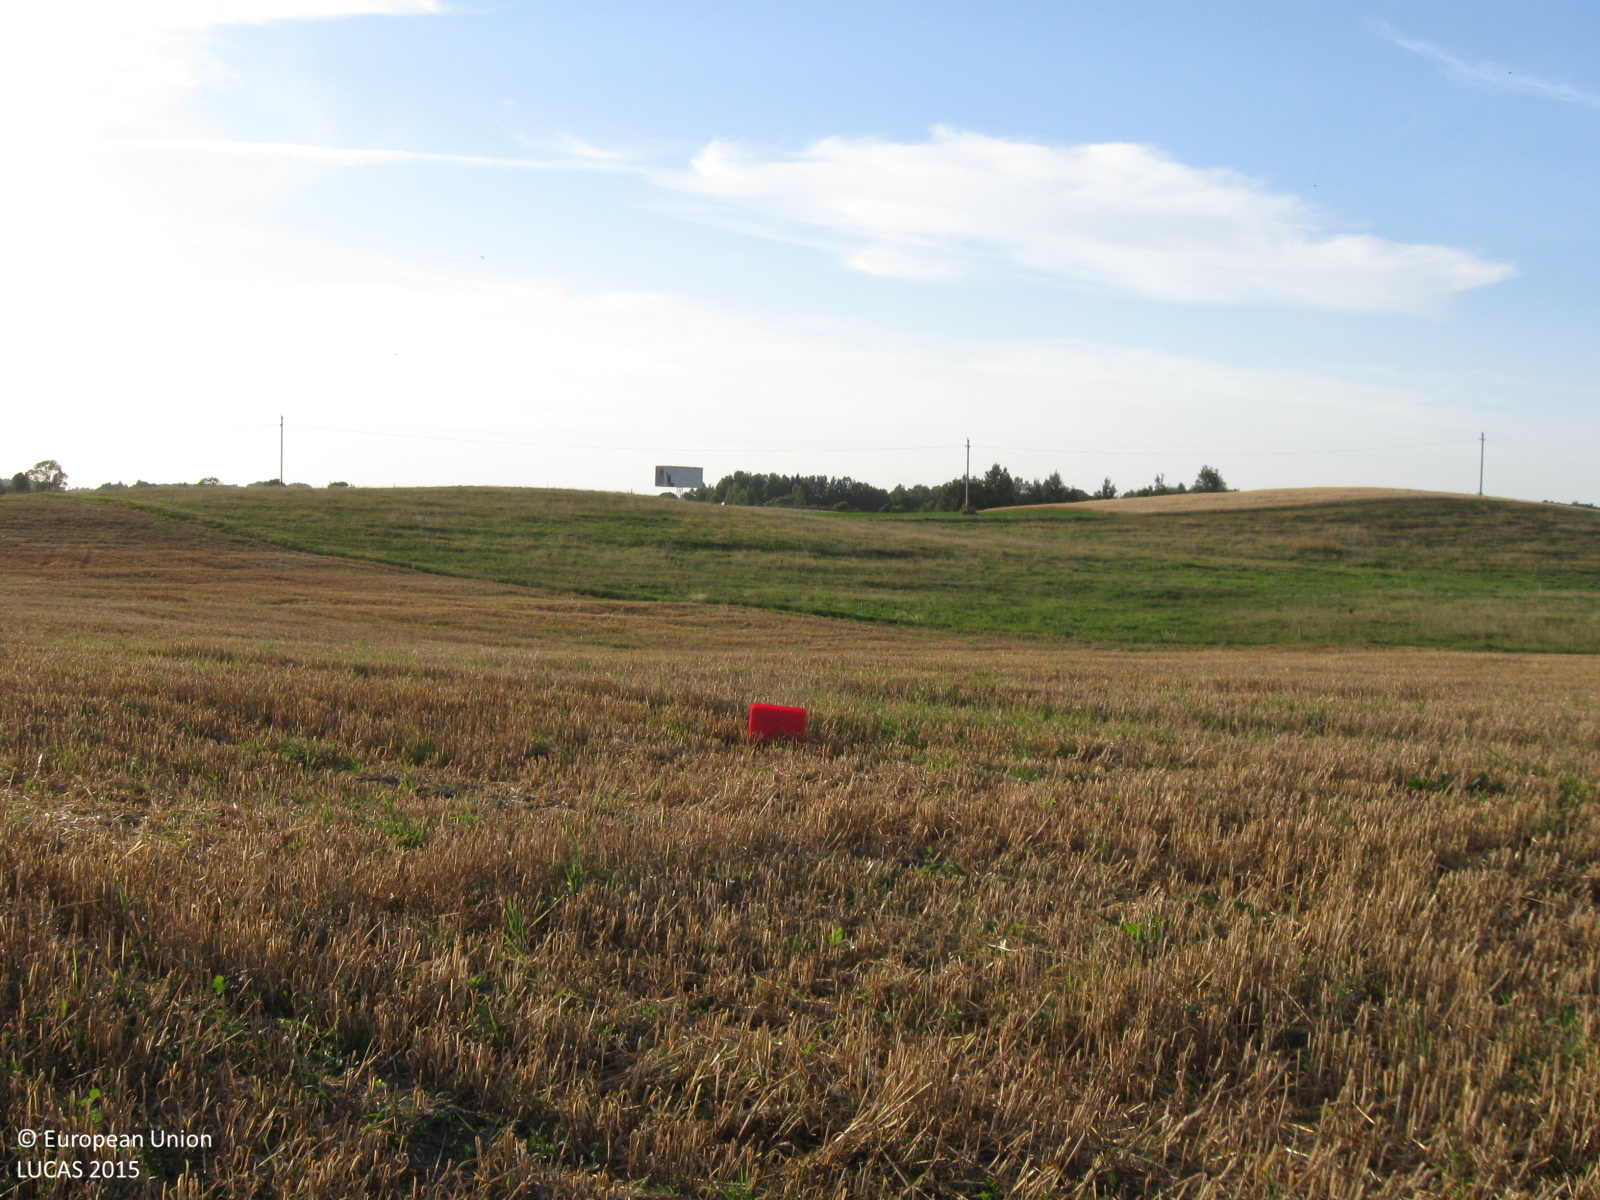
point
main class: Cropland
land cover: Barley
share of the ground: > 75 %
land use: Agriculture (excluding fallow land and kitchen gardens)
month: August
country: LT
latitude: 55.4685
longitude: 22.6388
